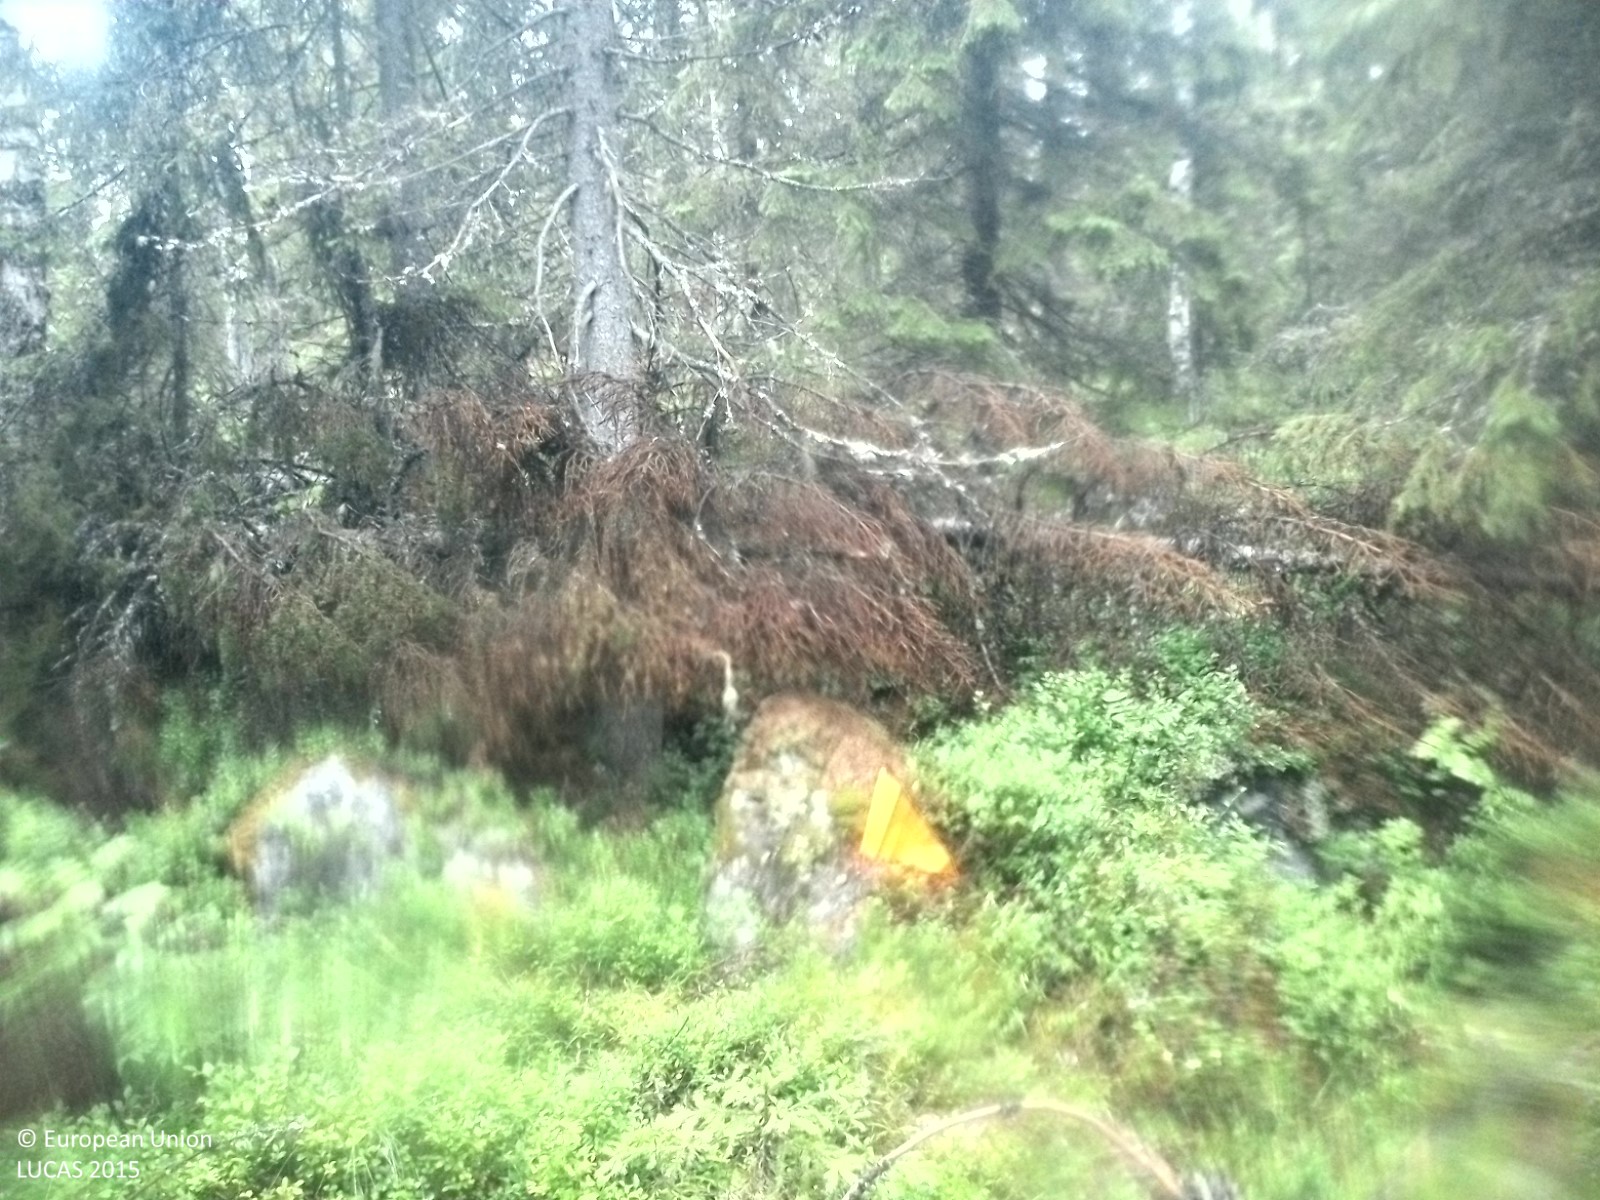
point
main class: Woodland
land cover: Spruce dominated mixed woodland
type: boreal forest
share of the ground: 50 - 75 %
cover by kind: coniferous forest trees 45 %, broadleaved forest trees 25 %, shrubs 15 %, lichens and mosses 15 %
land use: Forestry
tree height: > 5 m
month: July
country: SE
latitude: 62.4309
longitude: 17.0104
